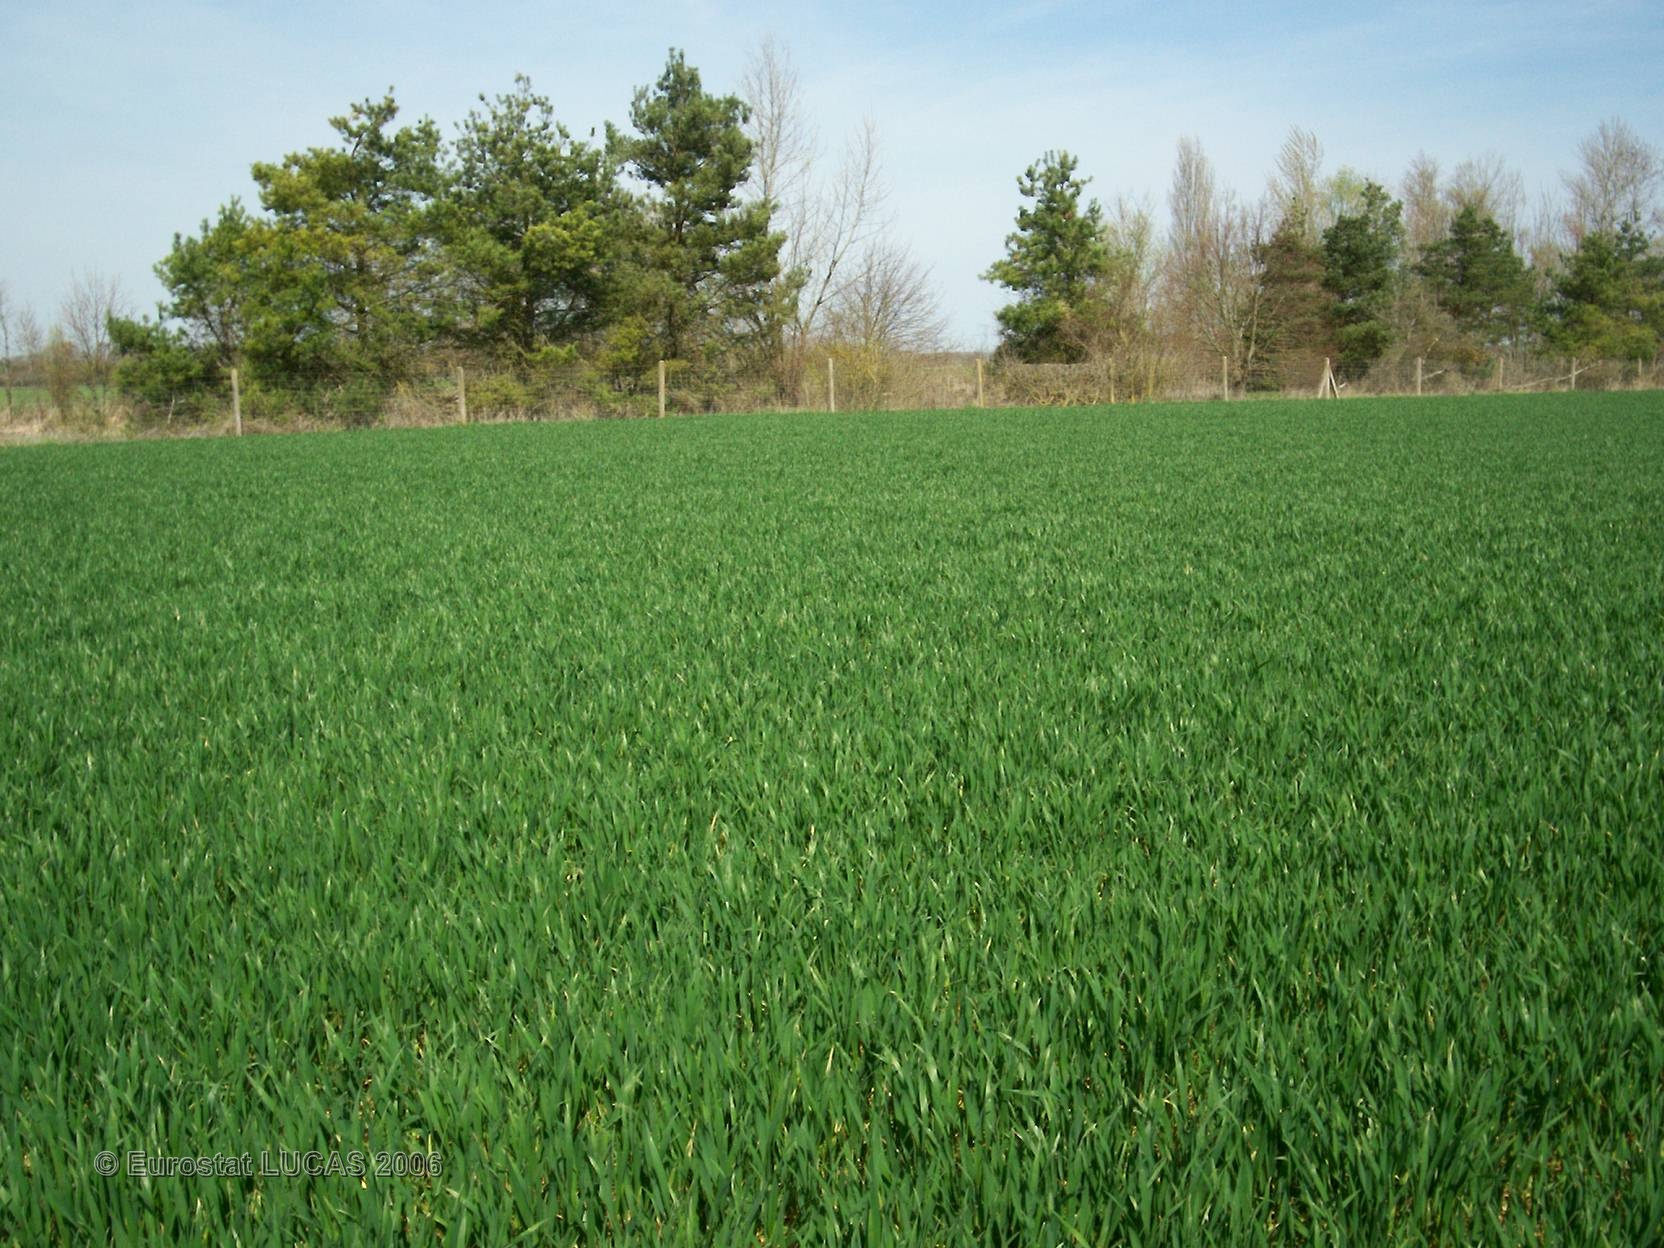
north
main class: Cropland
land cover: Common wheat
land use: Agriculture (excluding fallow land and kitchen gardens)
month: April
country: FR
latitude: 48.4301
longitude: 4.5238
